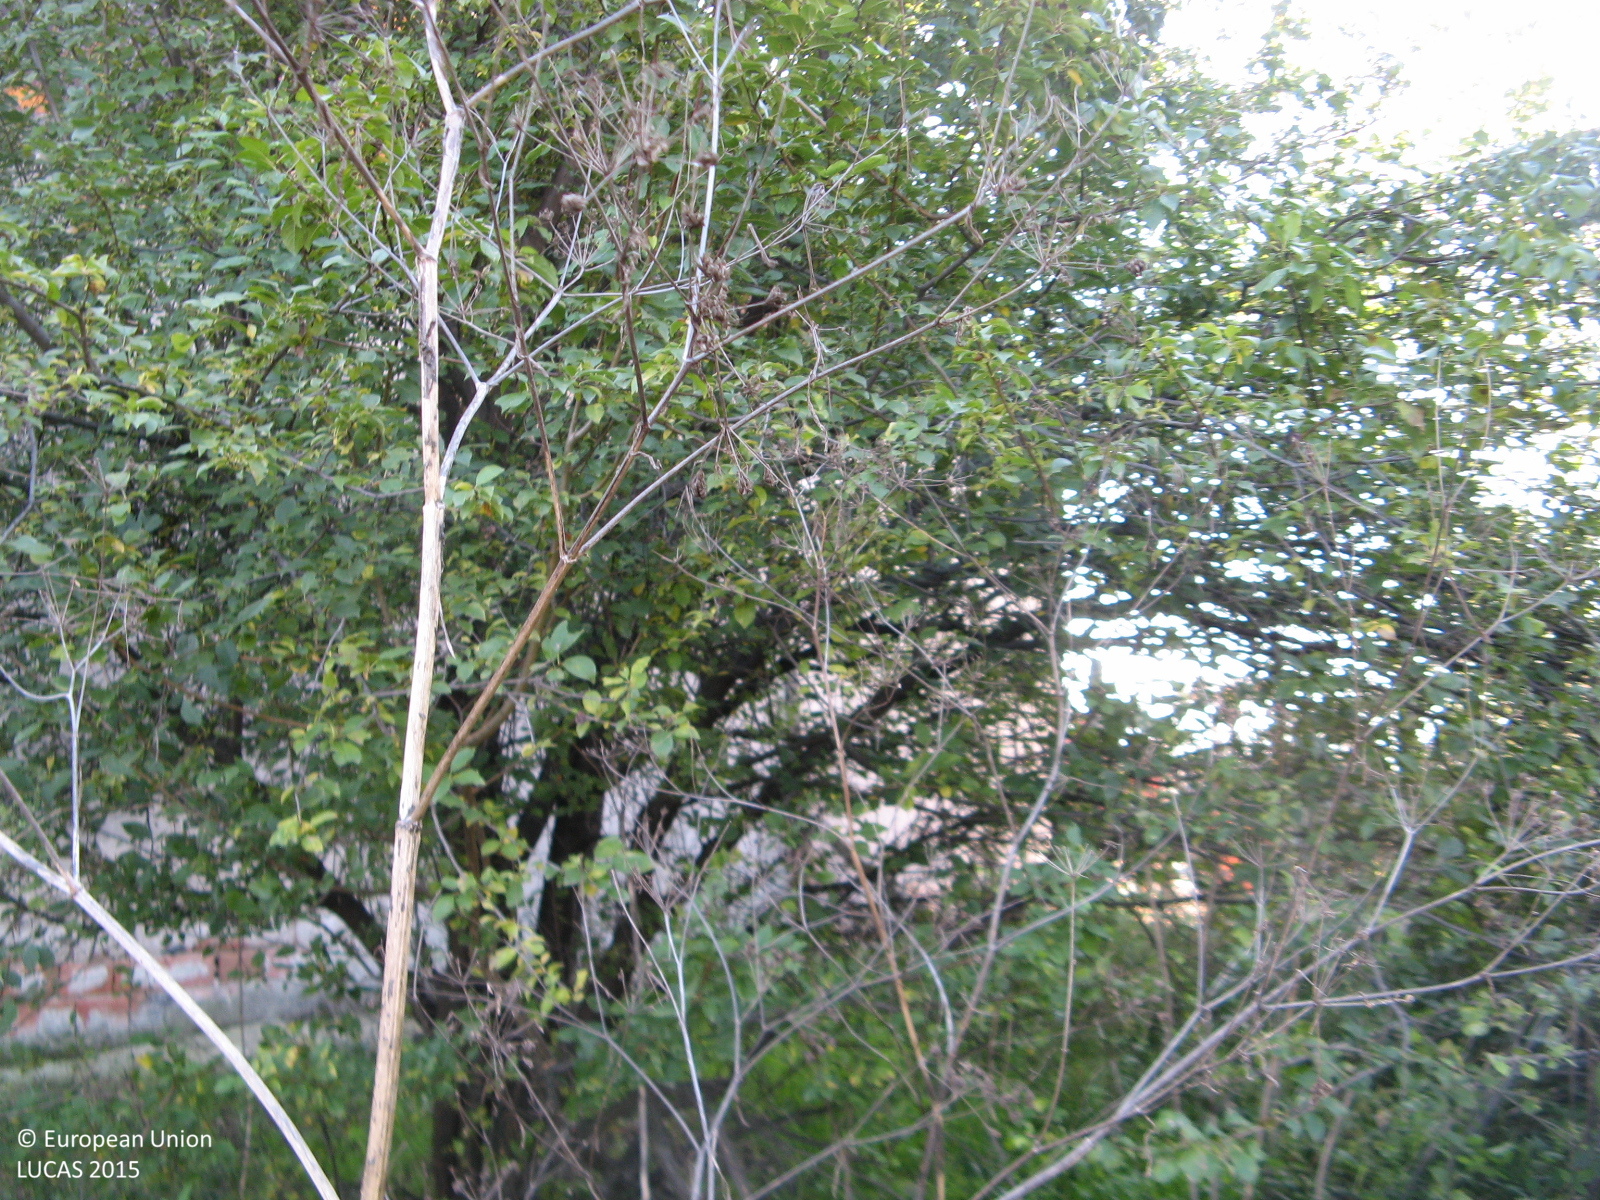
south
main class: Shrubland
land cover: Shrubland with sparse tree cover
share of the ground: > 75 %
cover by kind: shrubs 85 %, herbaceous plants 10 %, broadleaved forest trees 5 %
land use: Semi-natural and natural areas not in use
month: November
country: BG
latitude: 41.9796
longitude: 25.0568
